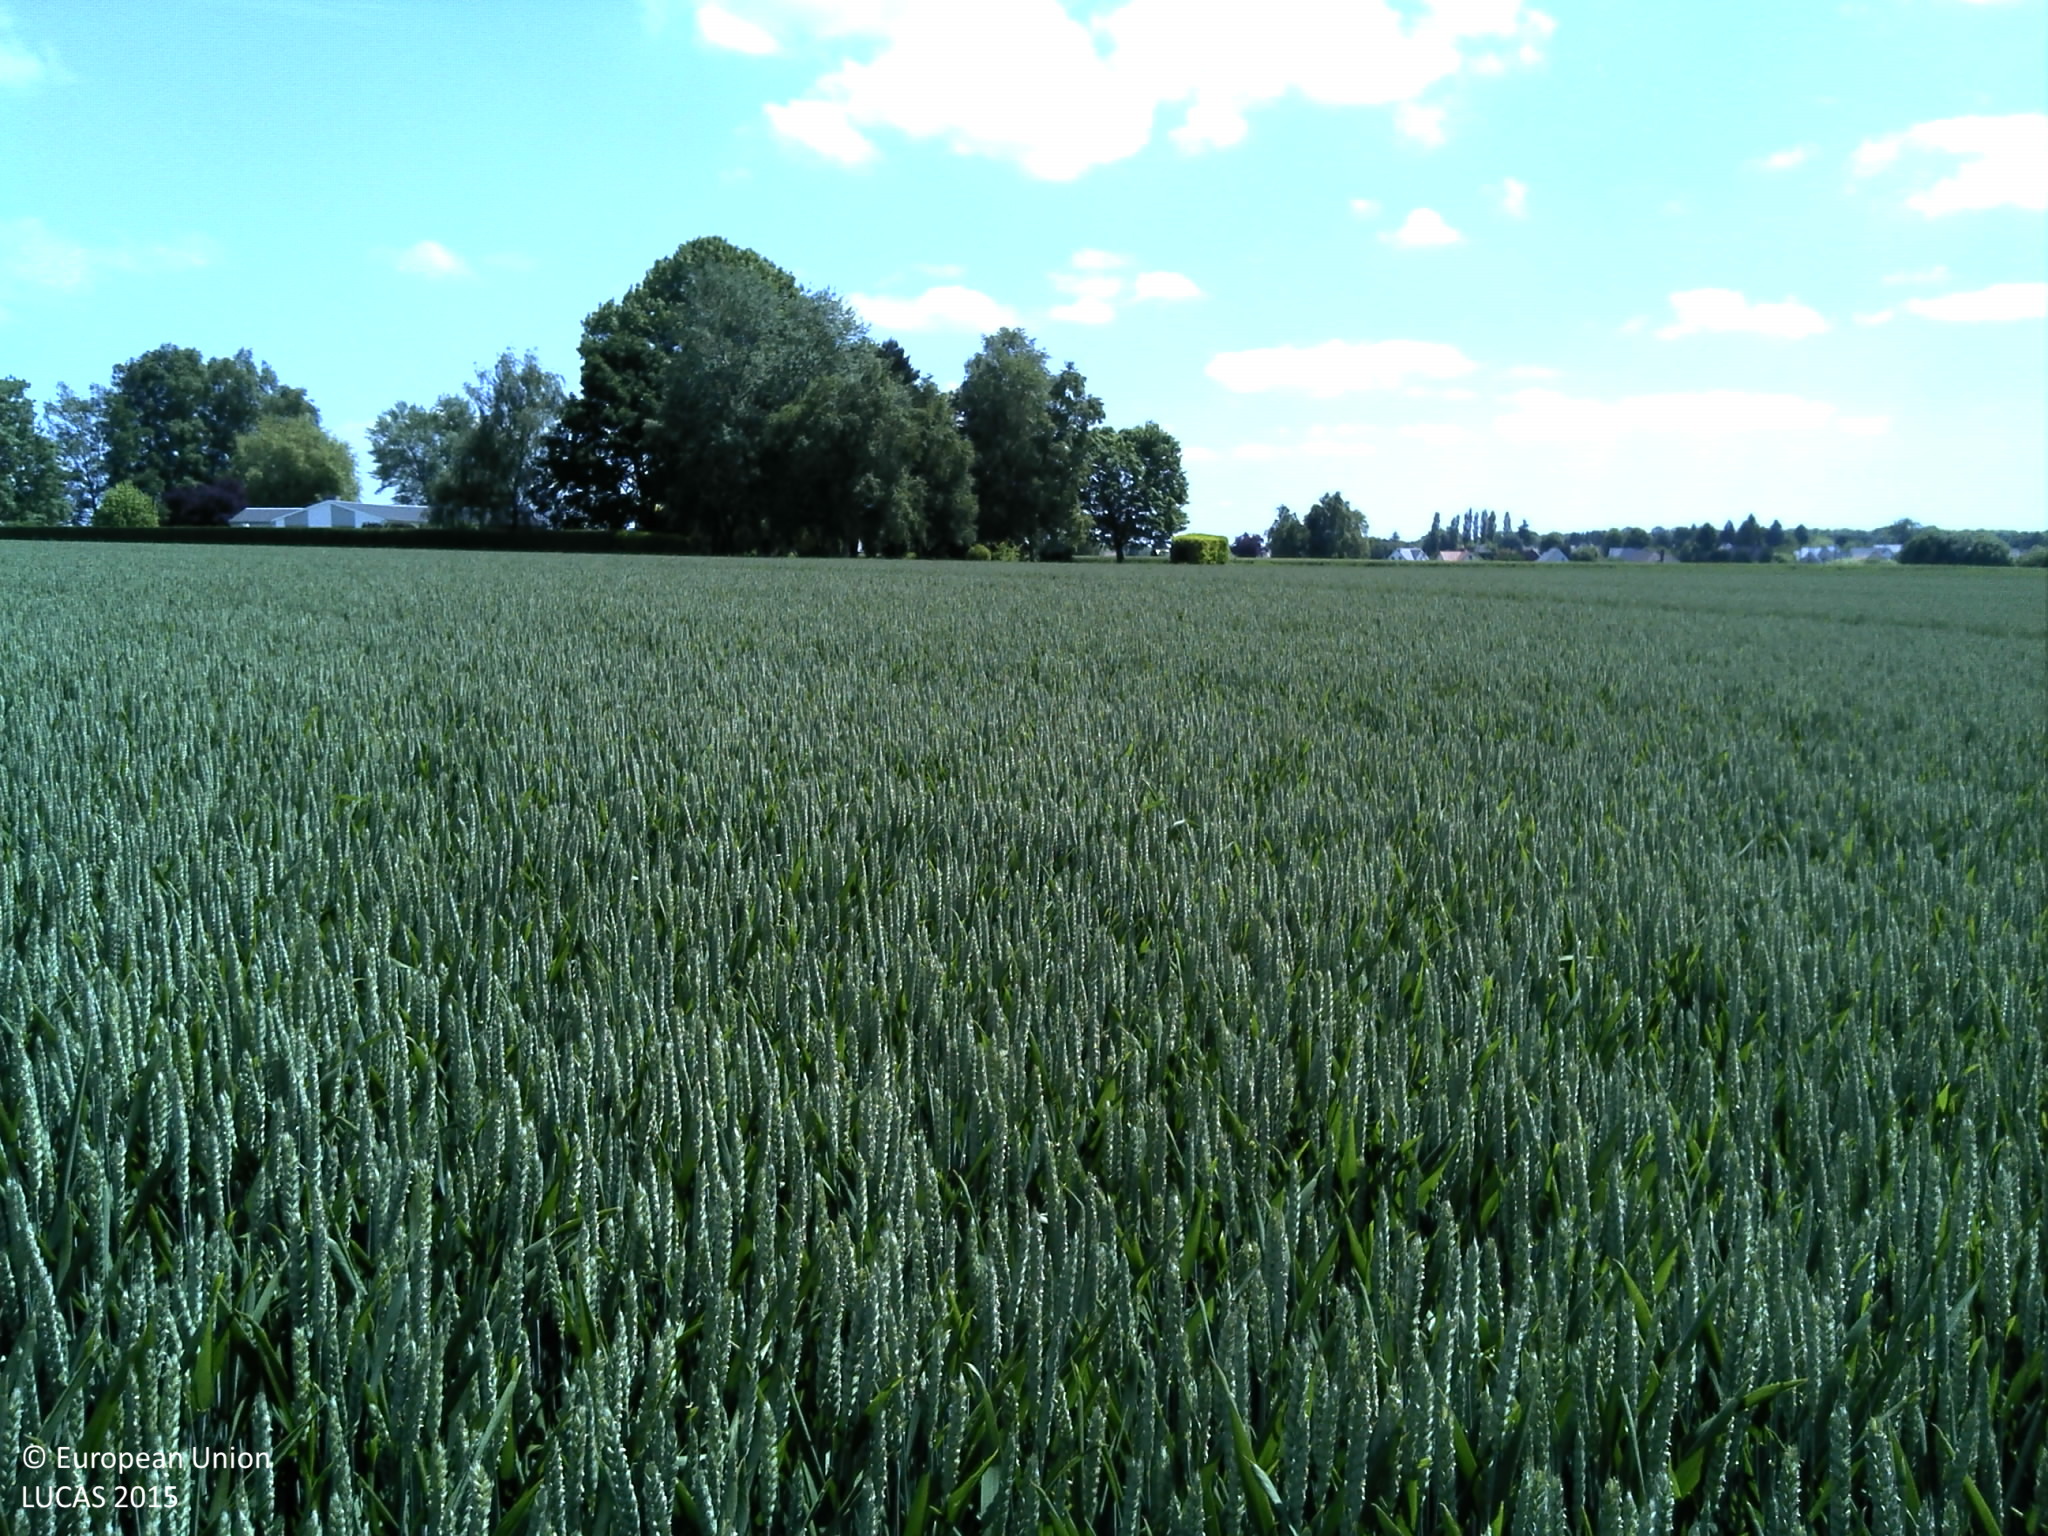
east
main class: Cropland
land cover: Common wheat
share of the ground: > 75 %
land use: Agriculture (excluding fallow land and kitchen gardens)
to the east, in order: Common wheat; Broadleaved woodland; Grassland with sparse tree/shrub cover; Common wheat
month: June
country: FR
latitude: 49.5141
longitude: 1.1531
